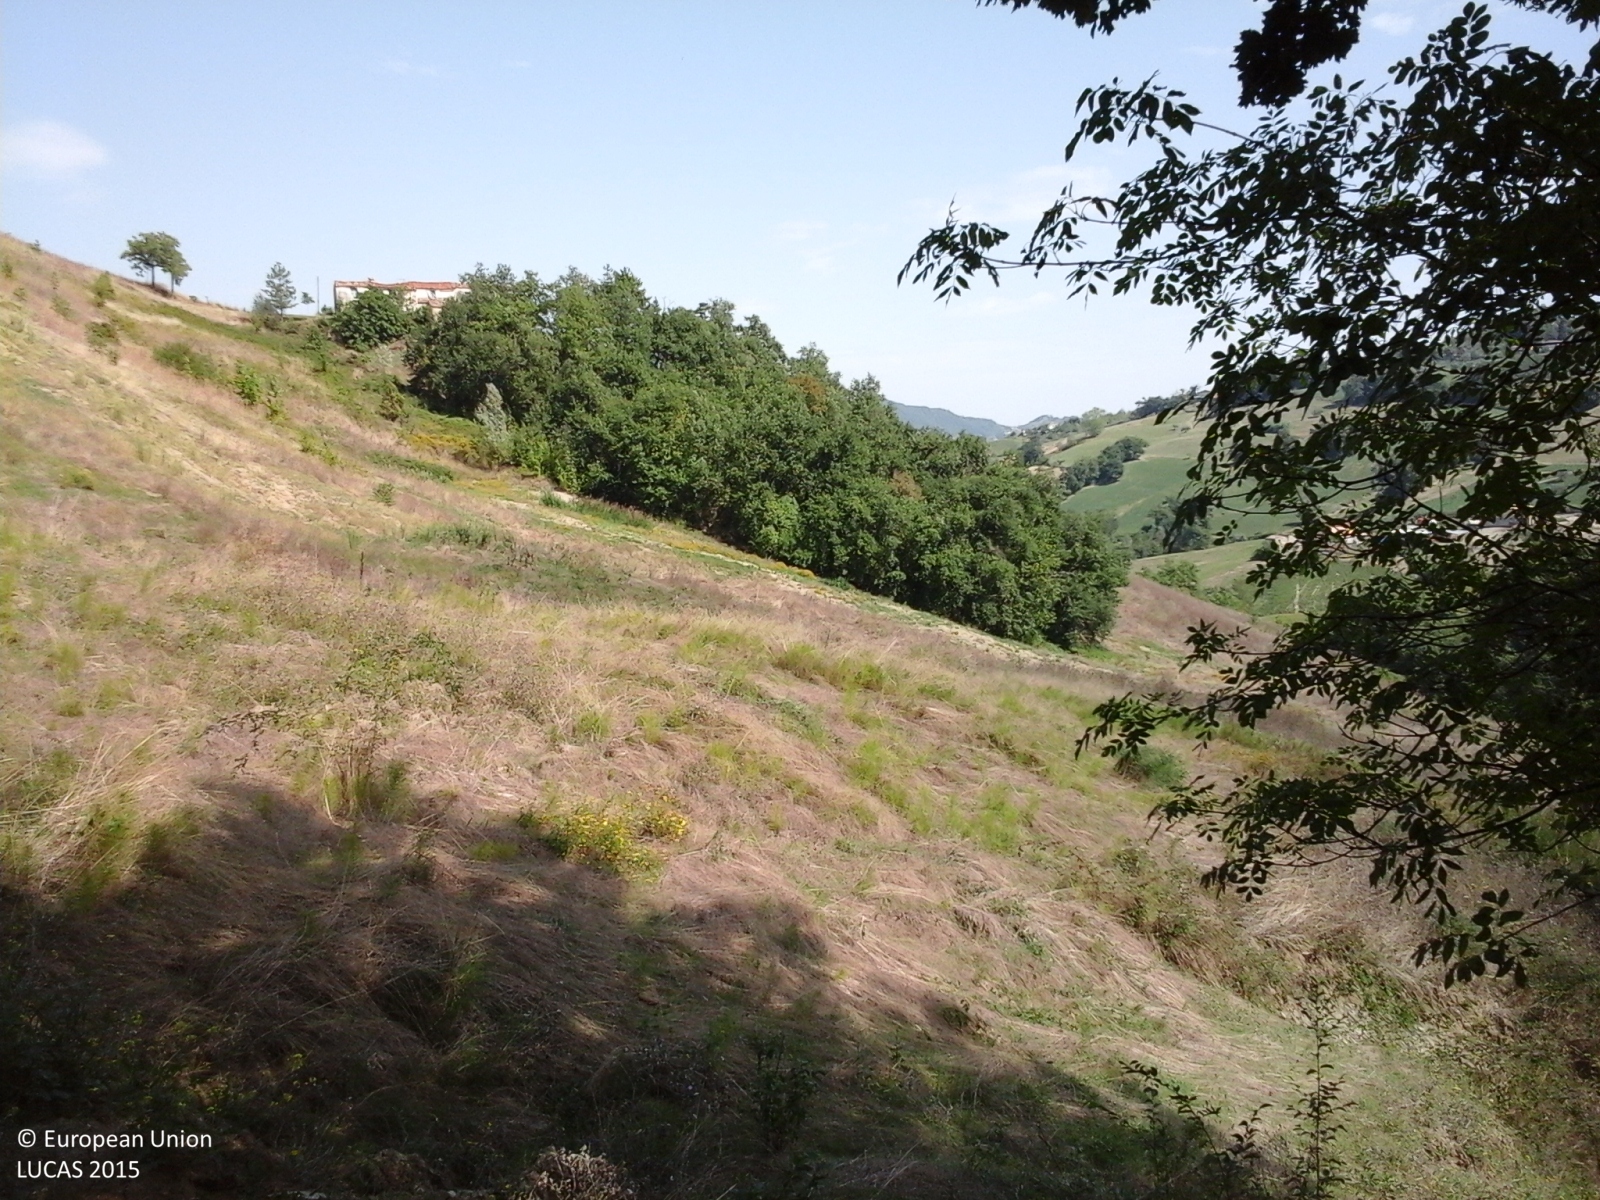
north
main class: Woodland
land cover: Broadleaved woodland
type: thermophilous deciduous forest
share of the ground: > 75 %
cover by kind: broadleaved forest trees 80 %, shrubs 10 %, herbaceous plants 10 %
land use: Semi-natural and natural areas not in use
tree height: > 5 m
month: September
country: IT
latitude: 42.5105
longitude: 13.7979
